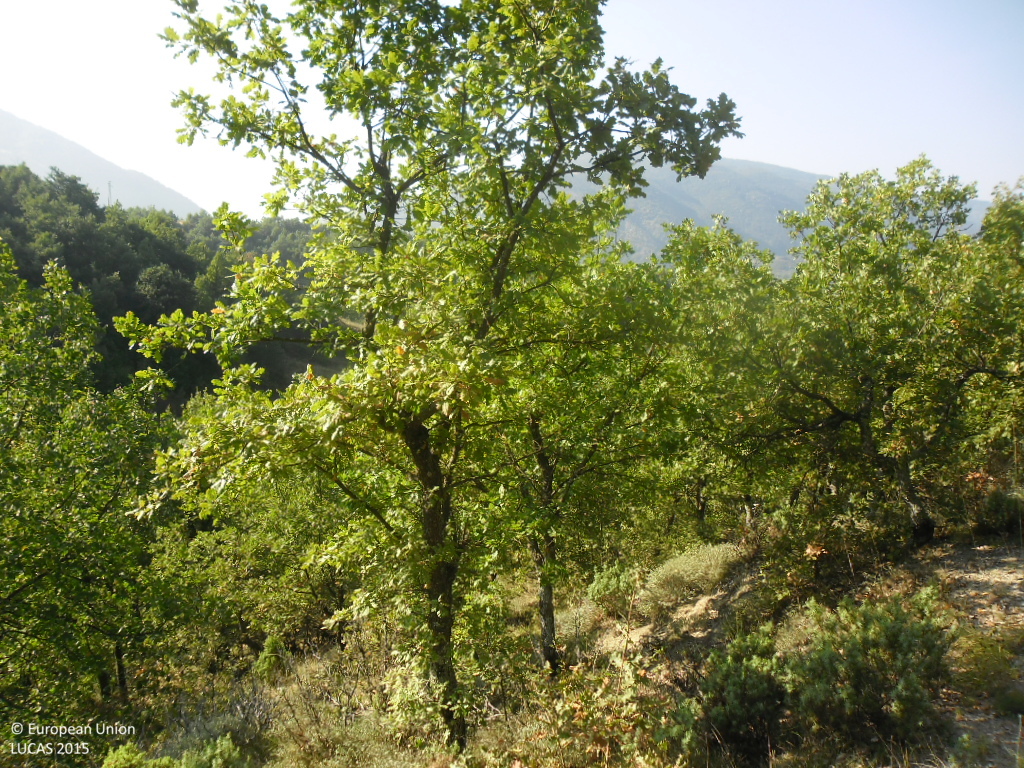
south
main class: Woodland
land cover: Broadleaved woodland
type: thermophilous deciduous forest
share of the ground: > 75 %
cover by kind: broadleaved forest trees 95 %, unconsolidated bare surface 5 %
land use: Forestry
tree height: > 5 m
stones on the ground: < 10 %
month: September
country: BG
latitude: 41.8665
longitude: 23.1432
